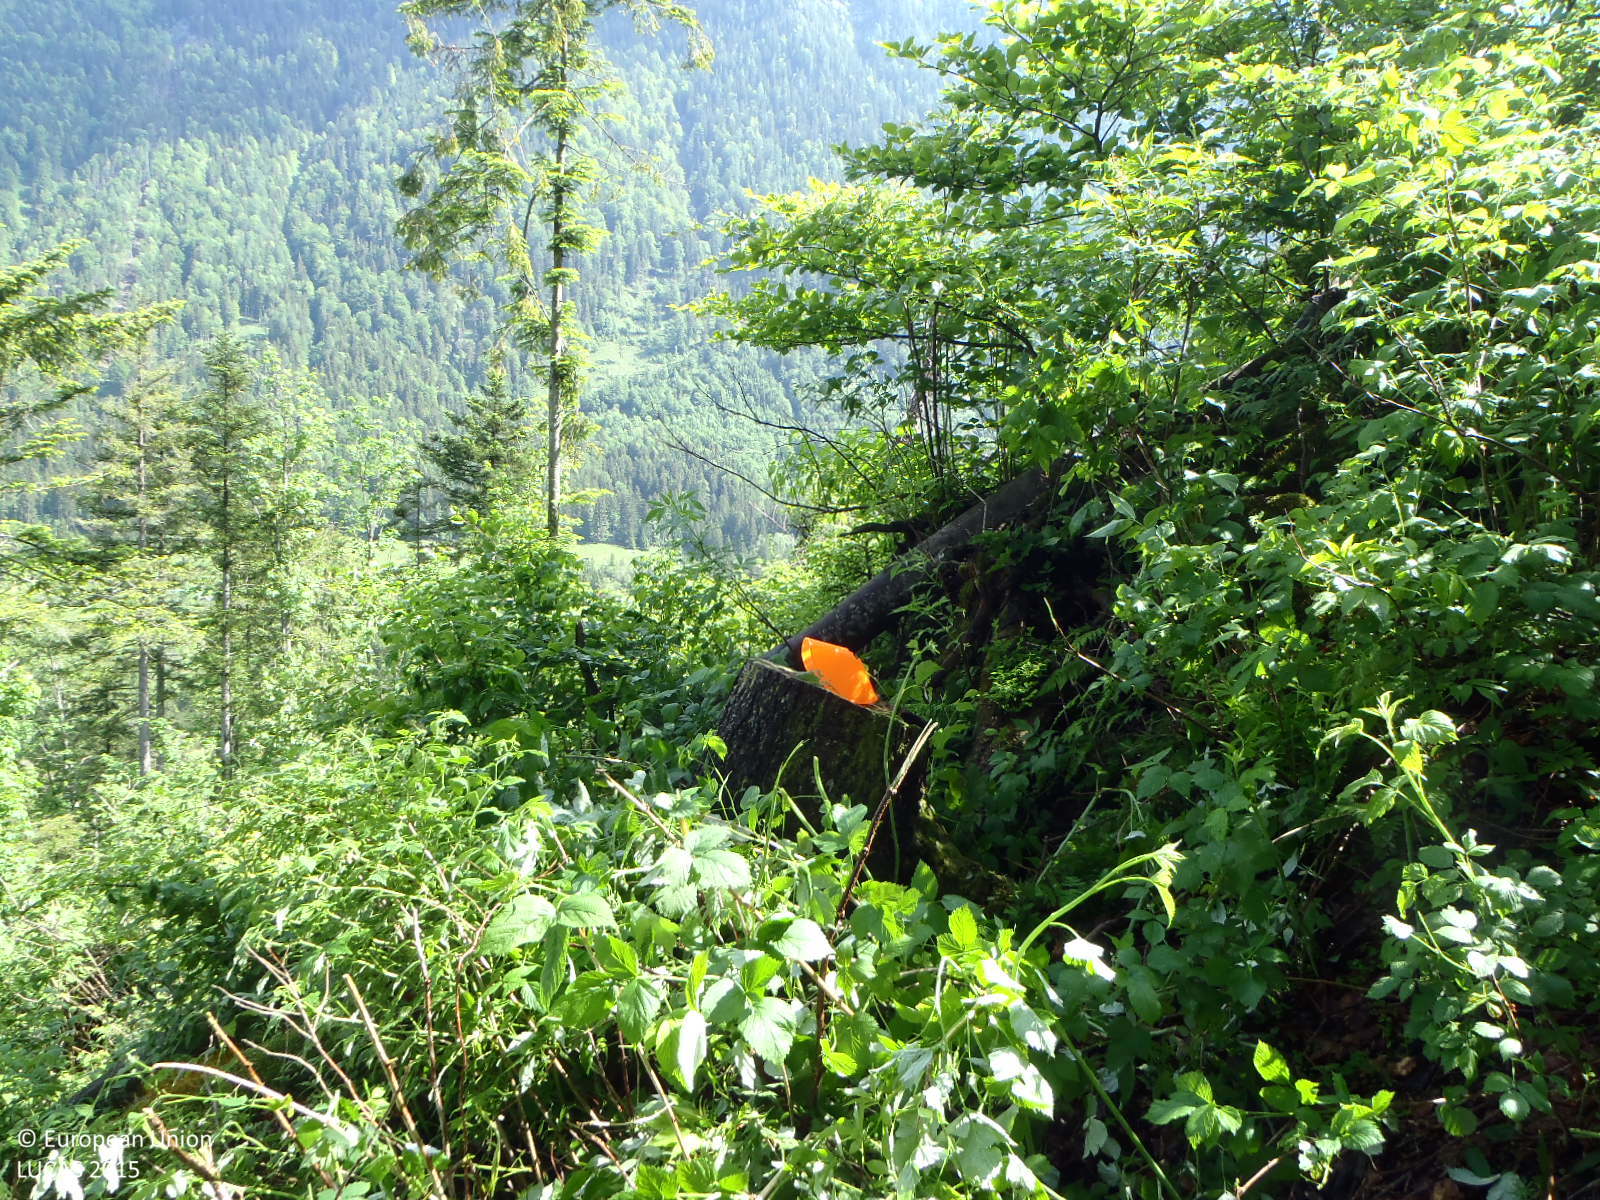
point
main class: Shrubland
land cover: Shrubland with sparse tree cover
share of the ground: > 75 %
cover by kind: shrubs 75 %, herbaceous plants 20 %, coniferous forest trees 5 %
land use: Forestry
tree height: > 5 m
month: June
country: AT
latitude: 47.5803
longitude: 12.6176
